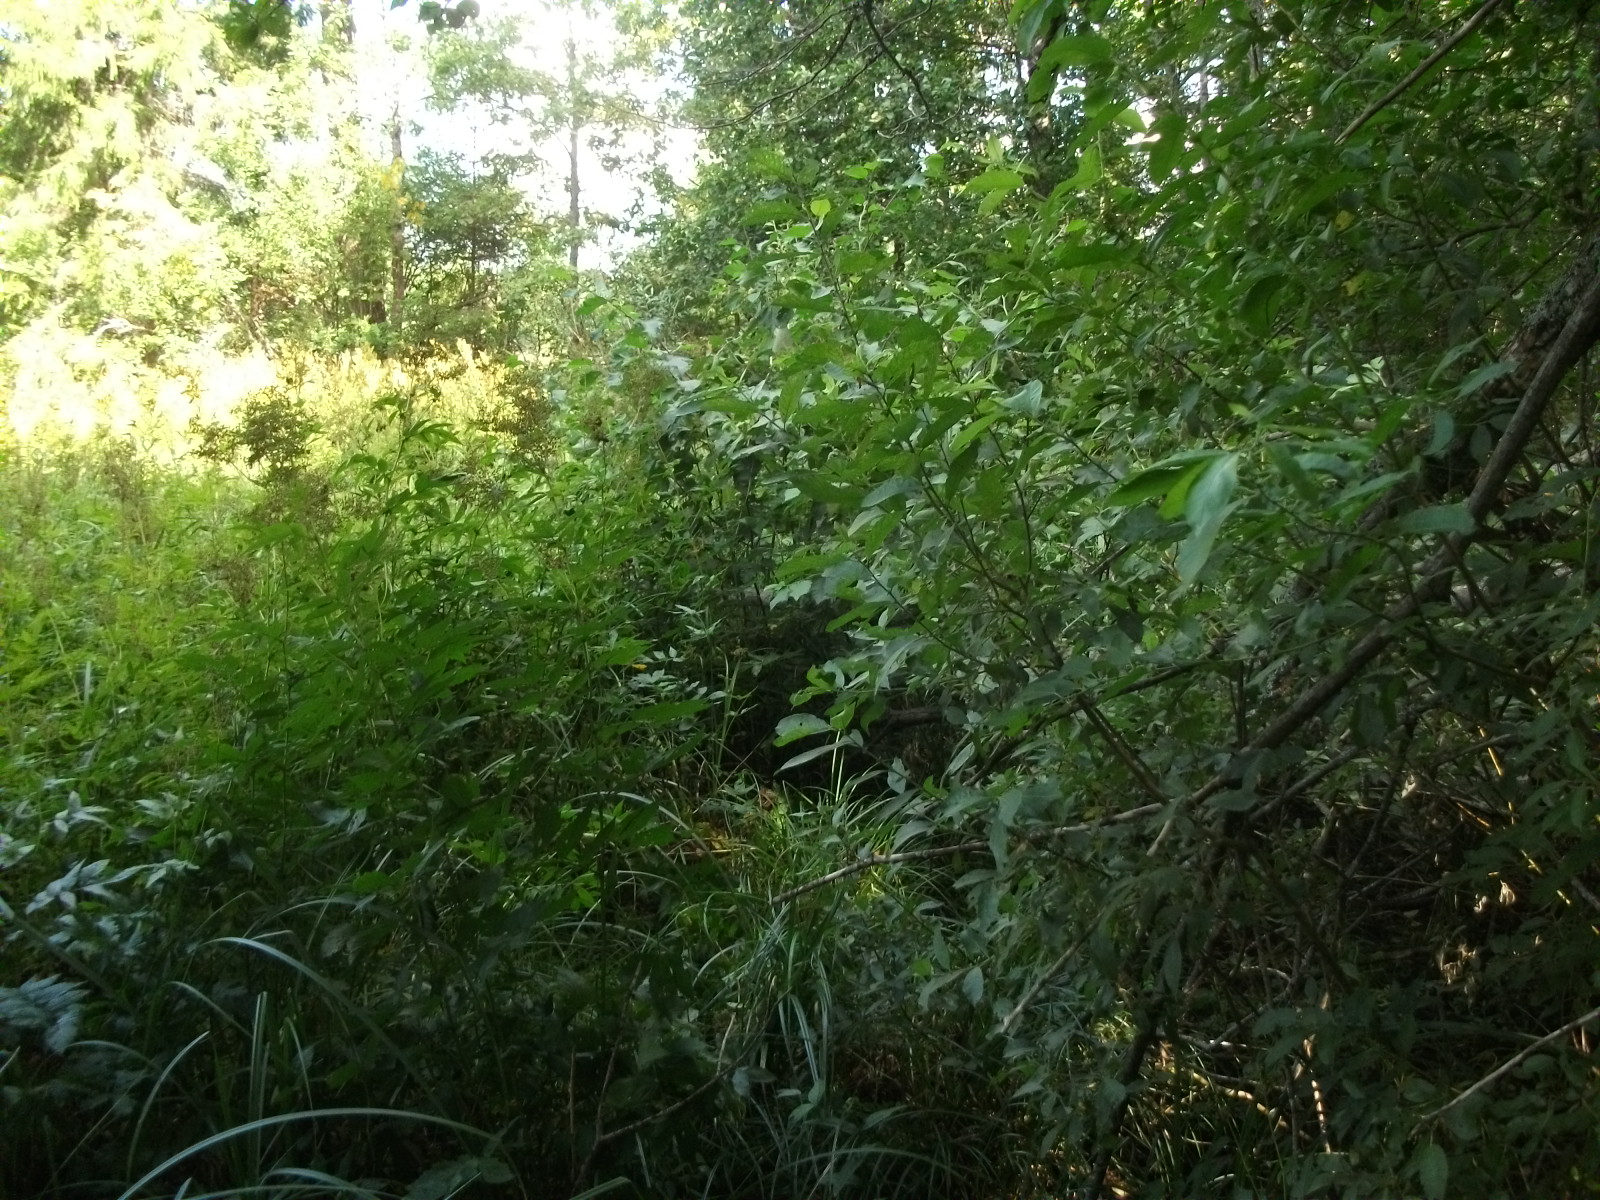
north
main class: Woodland
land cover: Broadleaved woodland
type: non-riverine alder, birch or aspen forest
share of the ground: > 75 %
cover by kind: broadleaved forest trees 90 %, shrubs 5 %, herbaceous plants 5 %
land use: Forestry
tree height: > 5 m
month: August
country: LV
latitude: 56.9045
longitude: 26.4163
